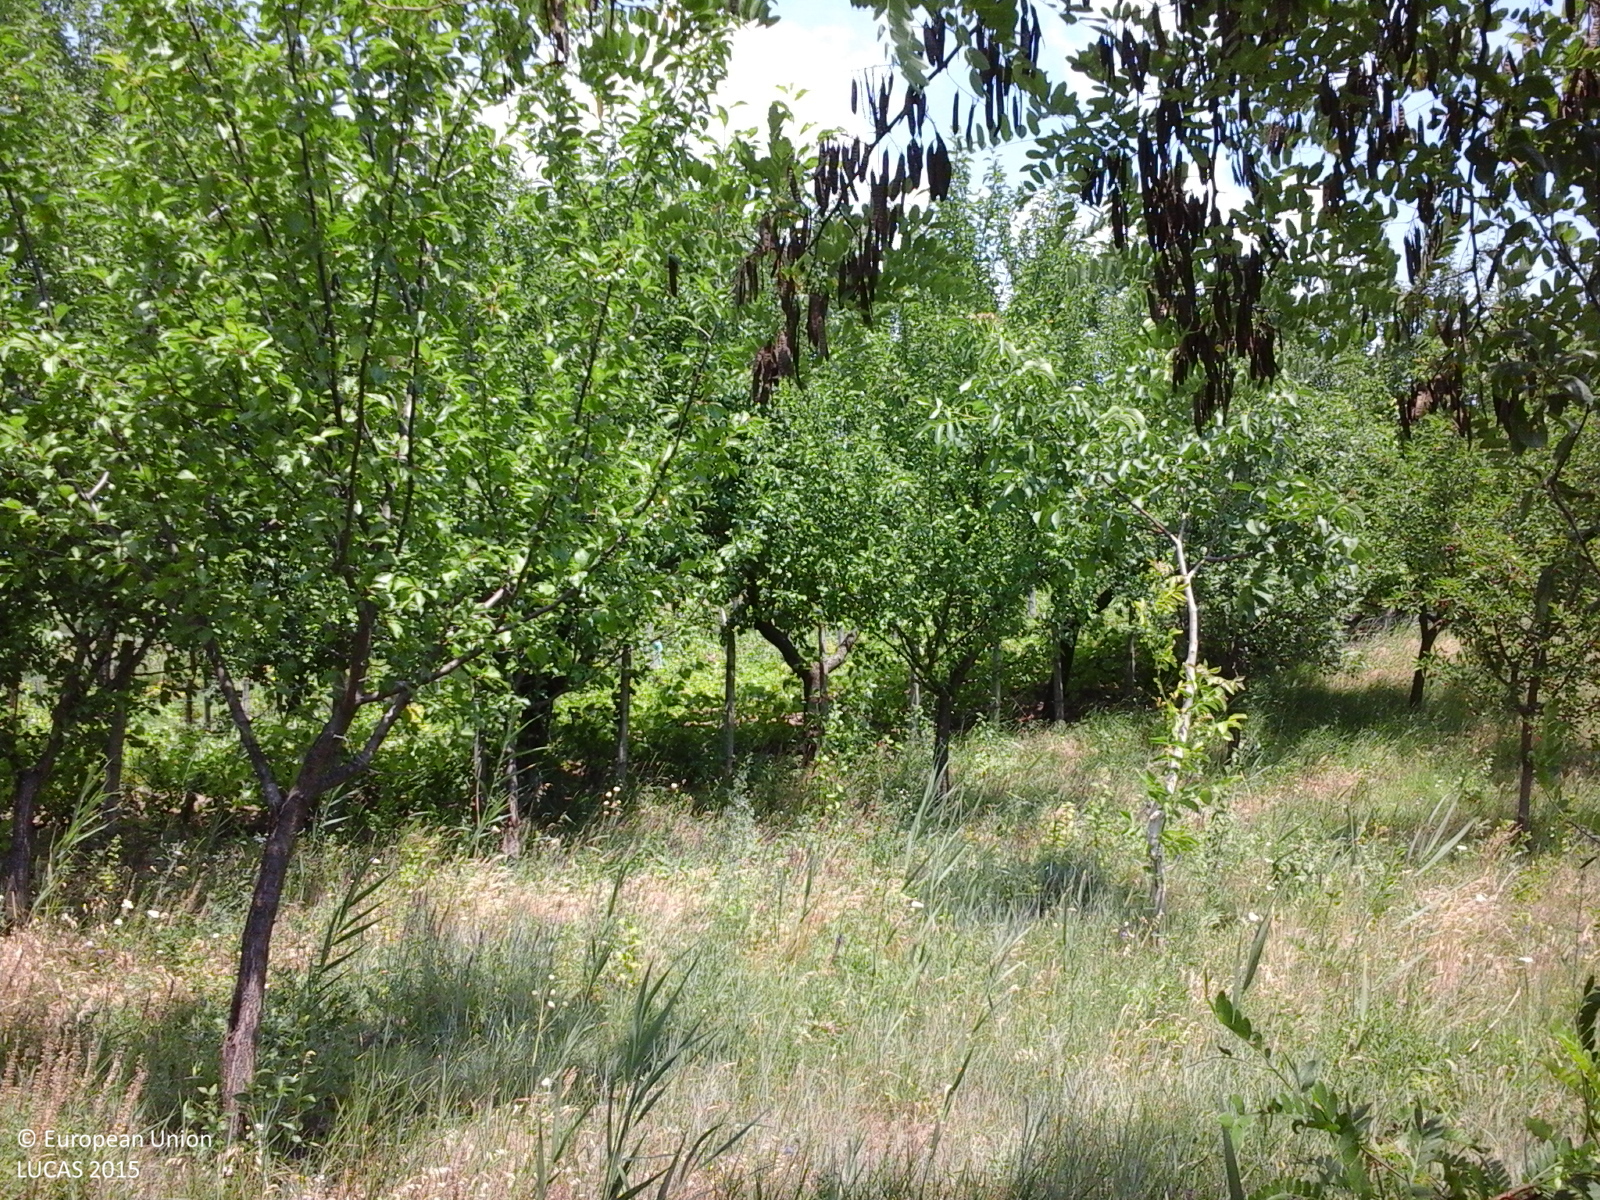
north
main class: Cropland
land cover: Vineyards
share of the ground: > 75 %
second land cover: Other bare soil
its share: > 75 %
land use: Agriculture (excluding fallow land and kitchen gardens)
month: June
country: RO
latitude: 47.2050
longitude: 27.6663
